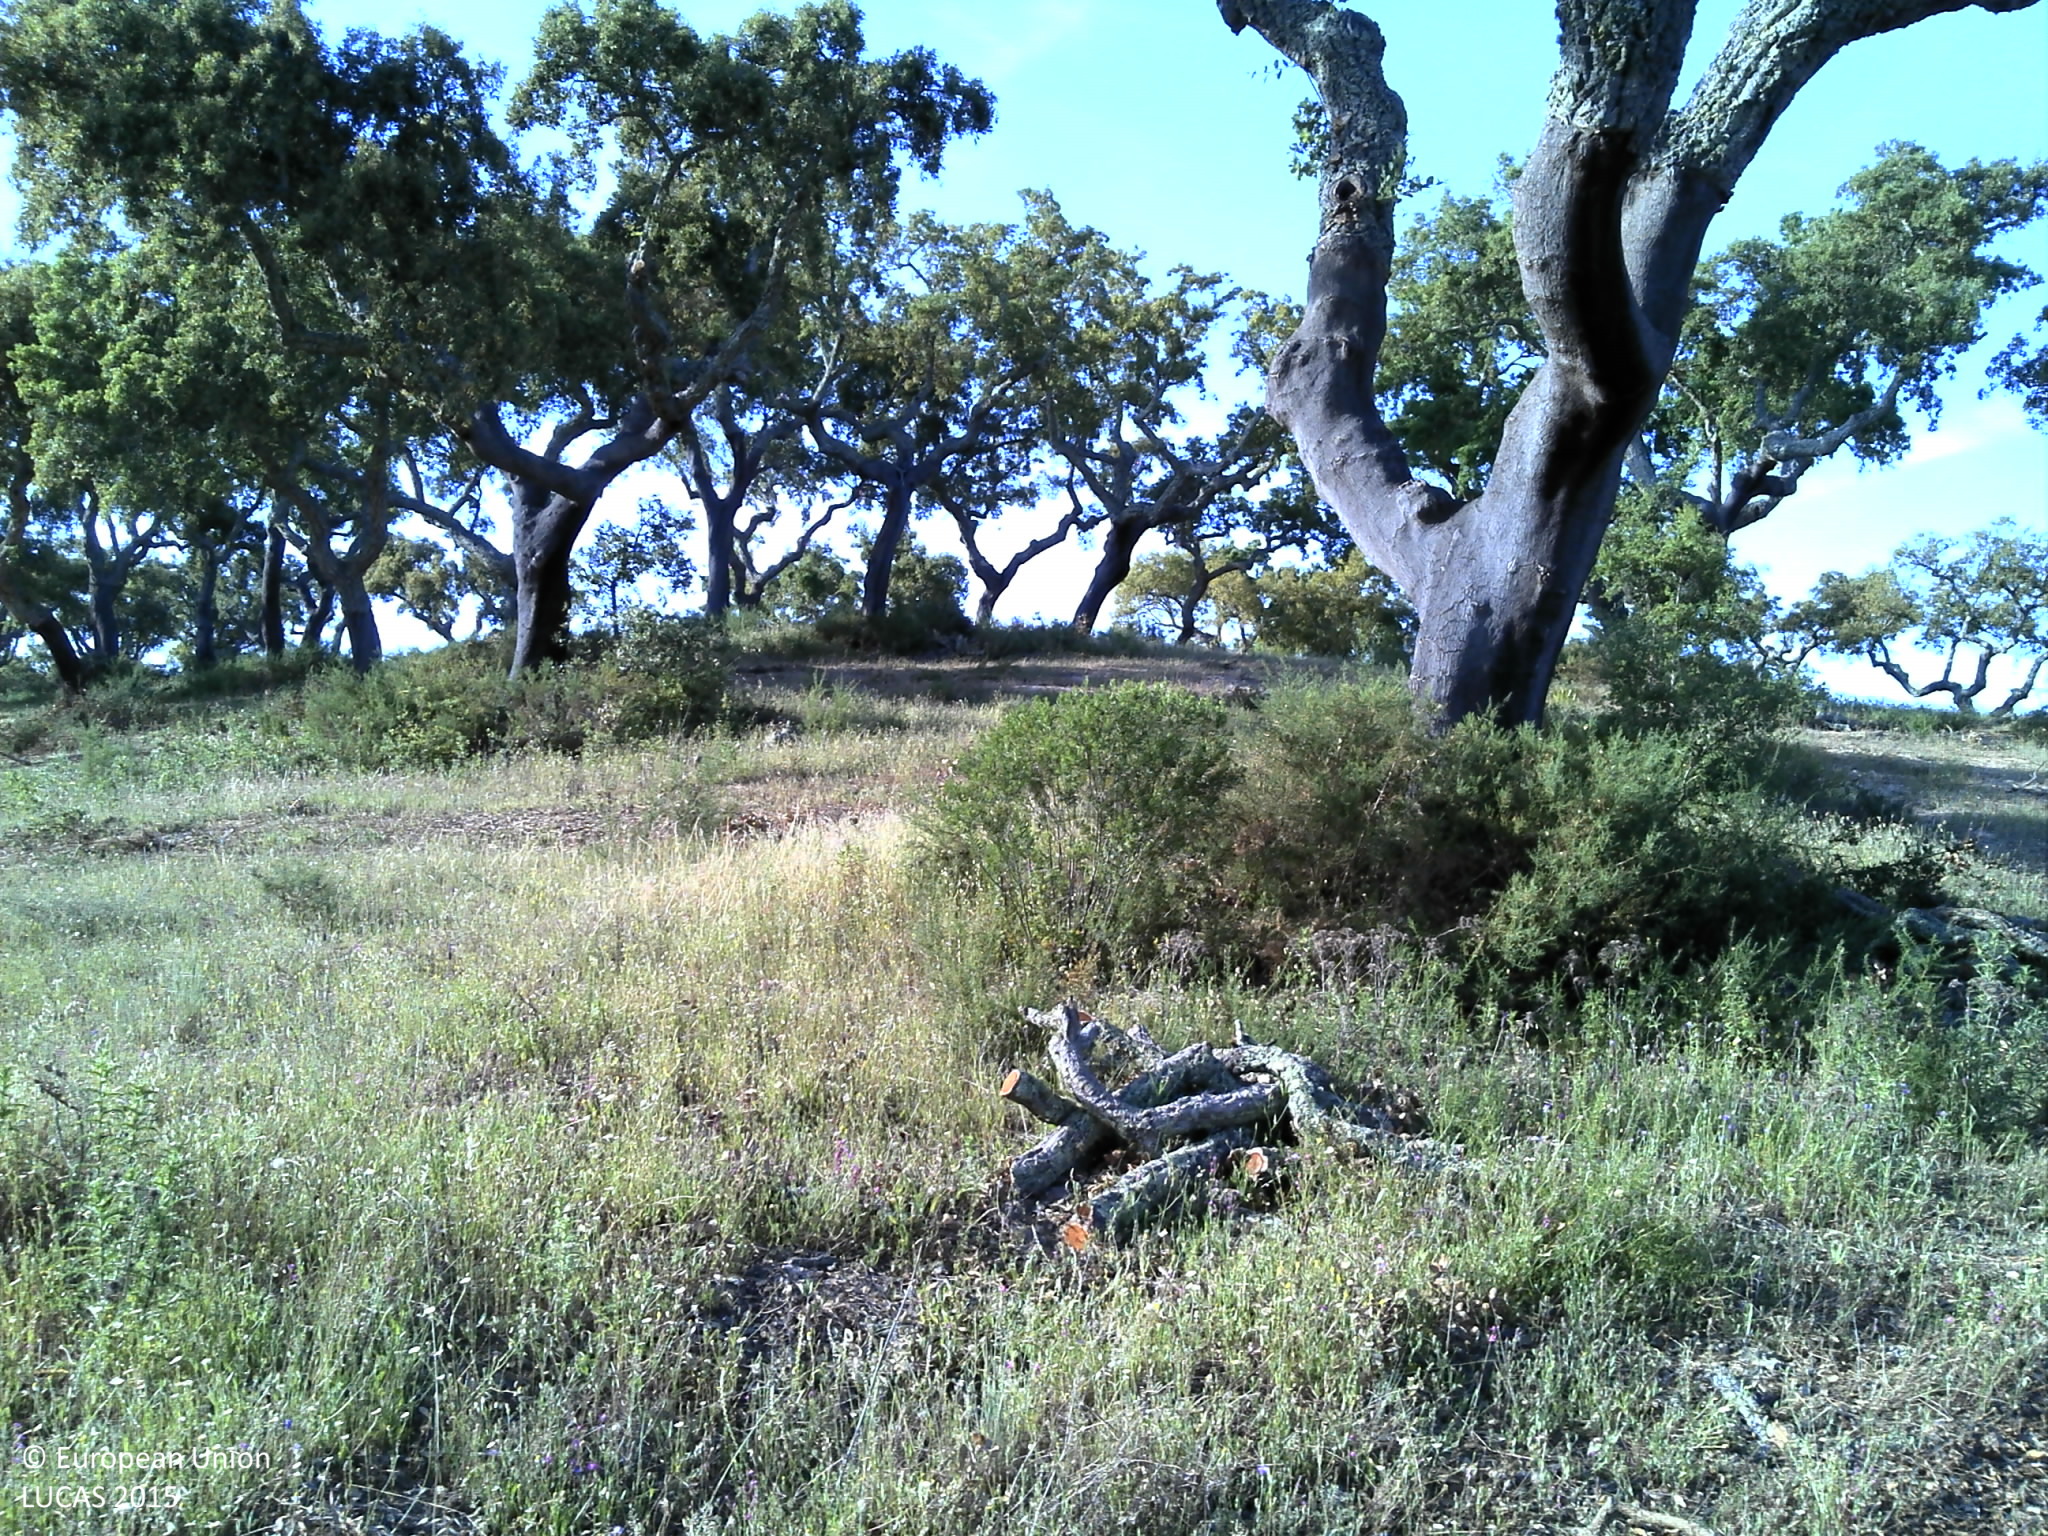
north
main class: Woodland
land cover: Broadleaved woodland
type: broadleaved evergreen forest
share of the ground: 25 - 50 %
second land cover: Grassland without tree/shrub cover
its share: 10 - 25 %
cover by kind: broadleaved forest trees 40 %, herbaceous plants 30 %, consolidated bare surface 30 %
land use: Forestry
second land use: Agriculture (excluding fallow land and kitchen gardens)
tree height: > 5 m
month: May
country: PT
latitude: 39.0845
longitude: -7.9102
